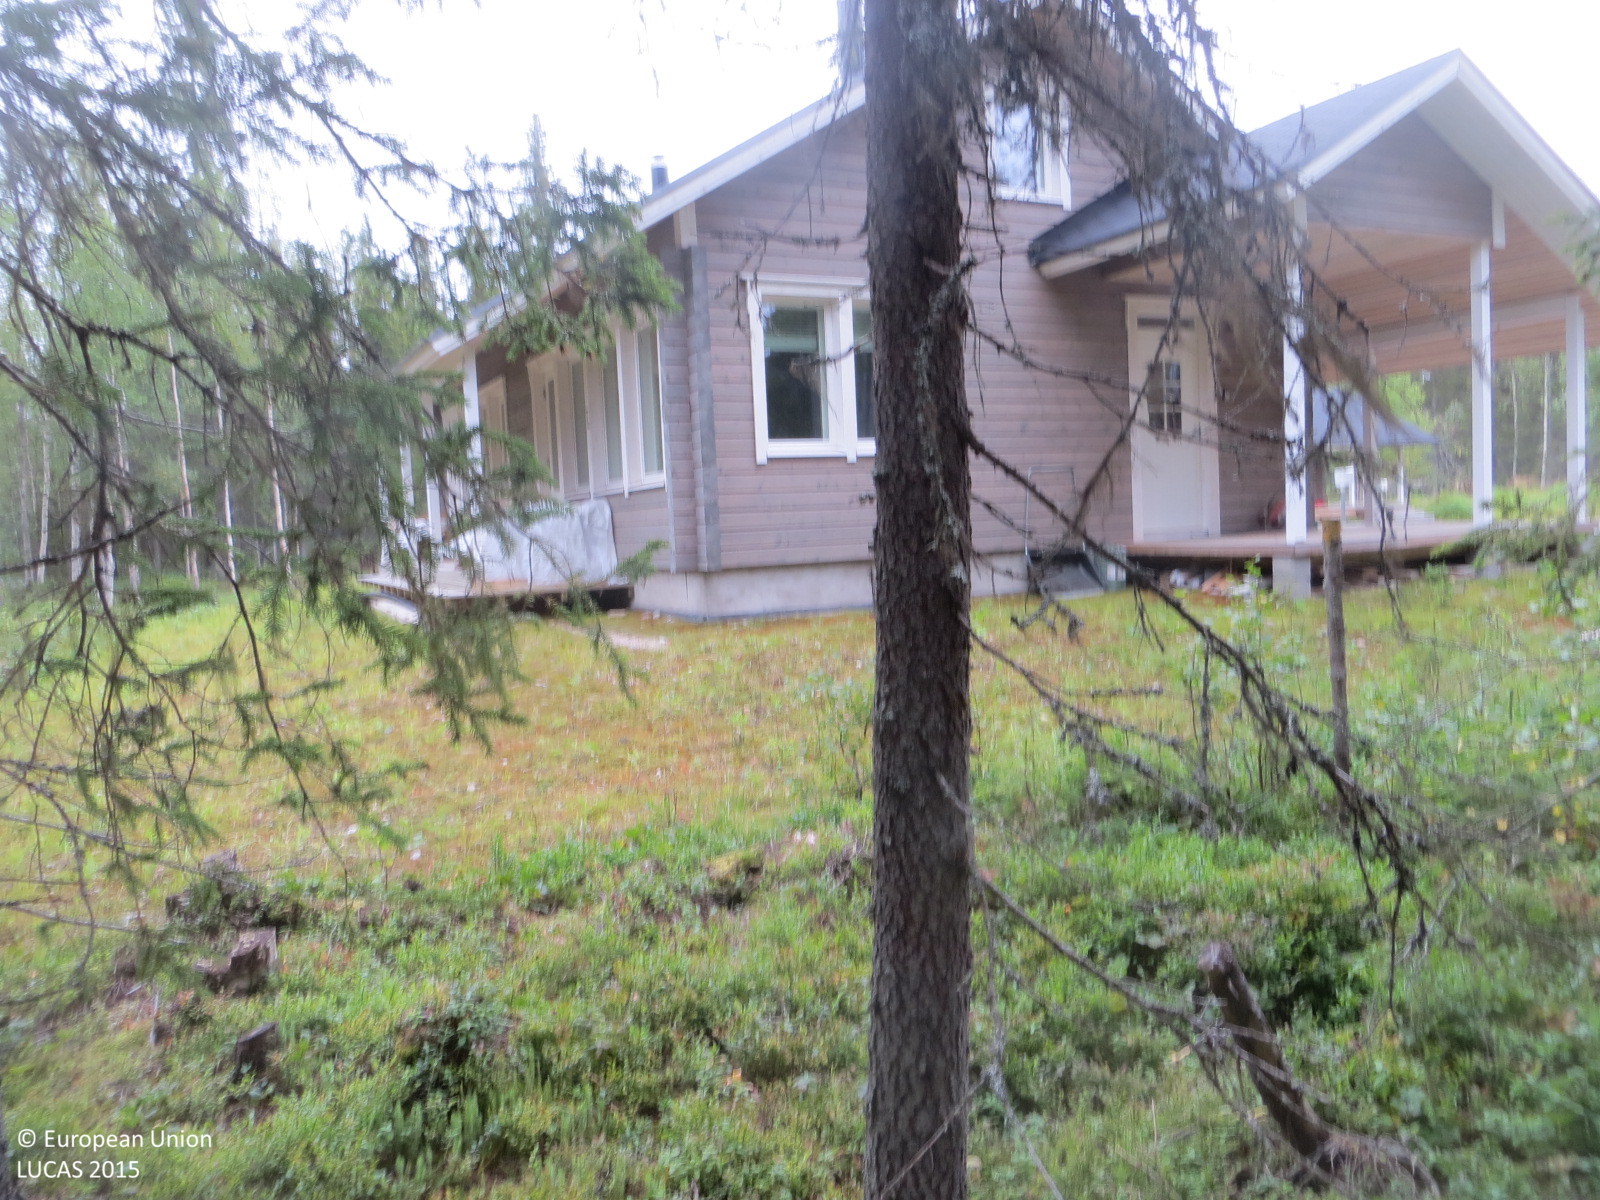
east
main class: Woodland
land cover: Spruce dominated coniferous woodland
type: boreal forest
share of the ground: > 75 %
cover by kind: coniferous forest trees 75 %, shrubs 25 %
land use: Forestry
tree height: > 5 m
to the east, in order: Spruce dominated coniferous woodland; Artificial constructions in urban areas; Spruce dominated mixed woodland; Ditches and canals; Grassland without tree/shrub cover; Paved roads, cycling and walking lanes; Ditches and canals; Grassland without tree/shrub cover; Spruce dominated mixed woodland; Spruce dominated coniferous woodland
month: August
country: FI
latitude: 67.5331
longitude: 24.2600
